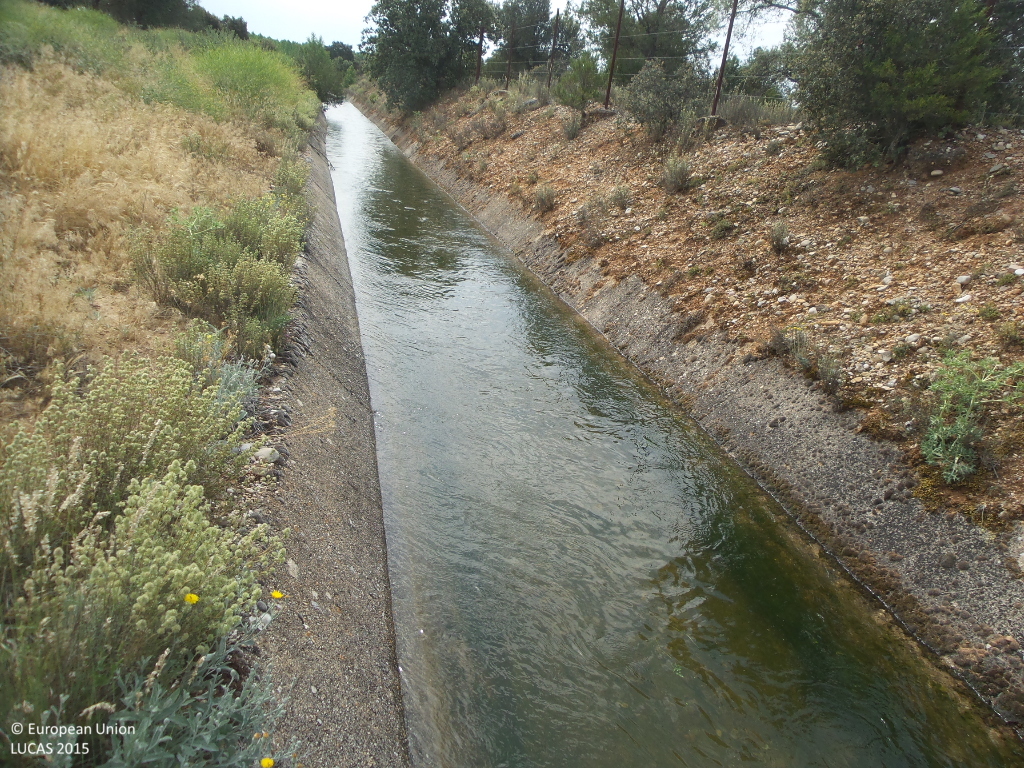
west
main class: Woodland
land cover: Broadleaved woodland
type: broadleaved evergreen forest
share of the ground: 10 - 25 %
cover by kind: herbaceous plants 40 %, shrubs 25 %, broadleaved forest trees 20 %, unconsolidated bare surface 10 %, coniferous forest trees 5 %
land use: Forestry
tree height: > 5 m
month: June
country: ES
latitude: 41.5258
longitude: -3.0938
